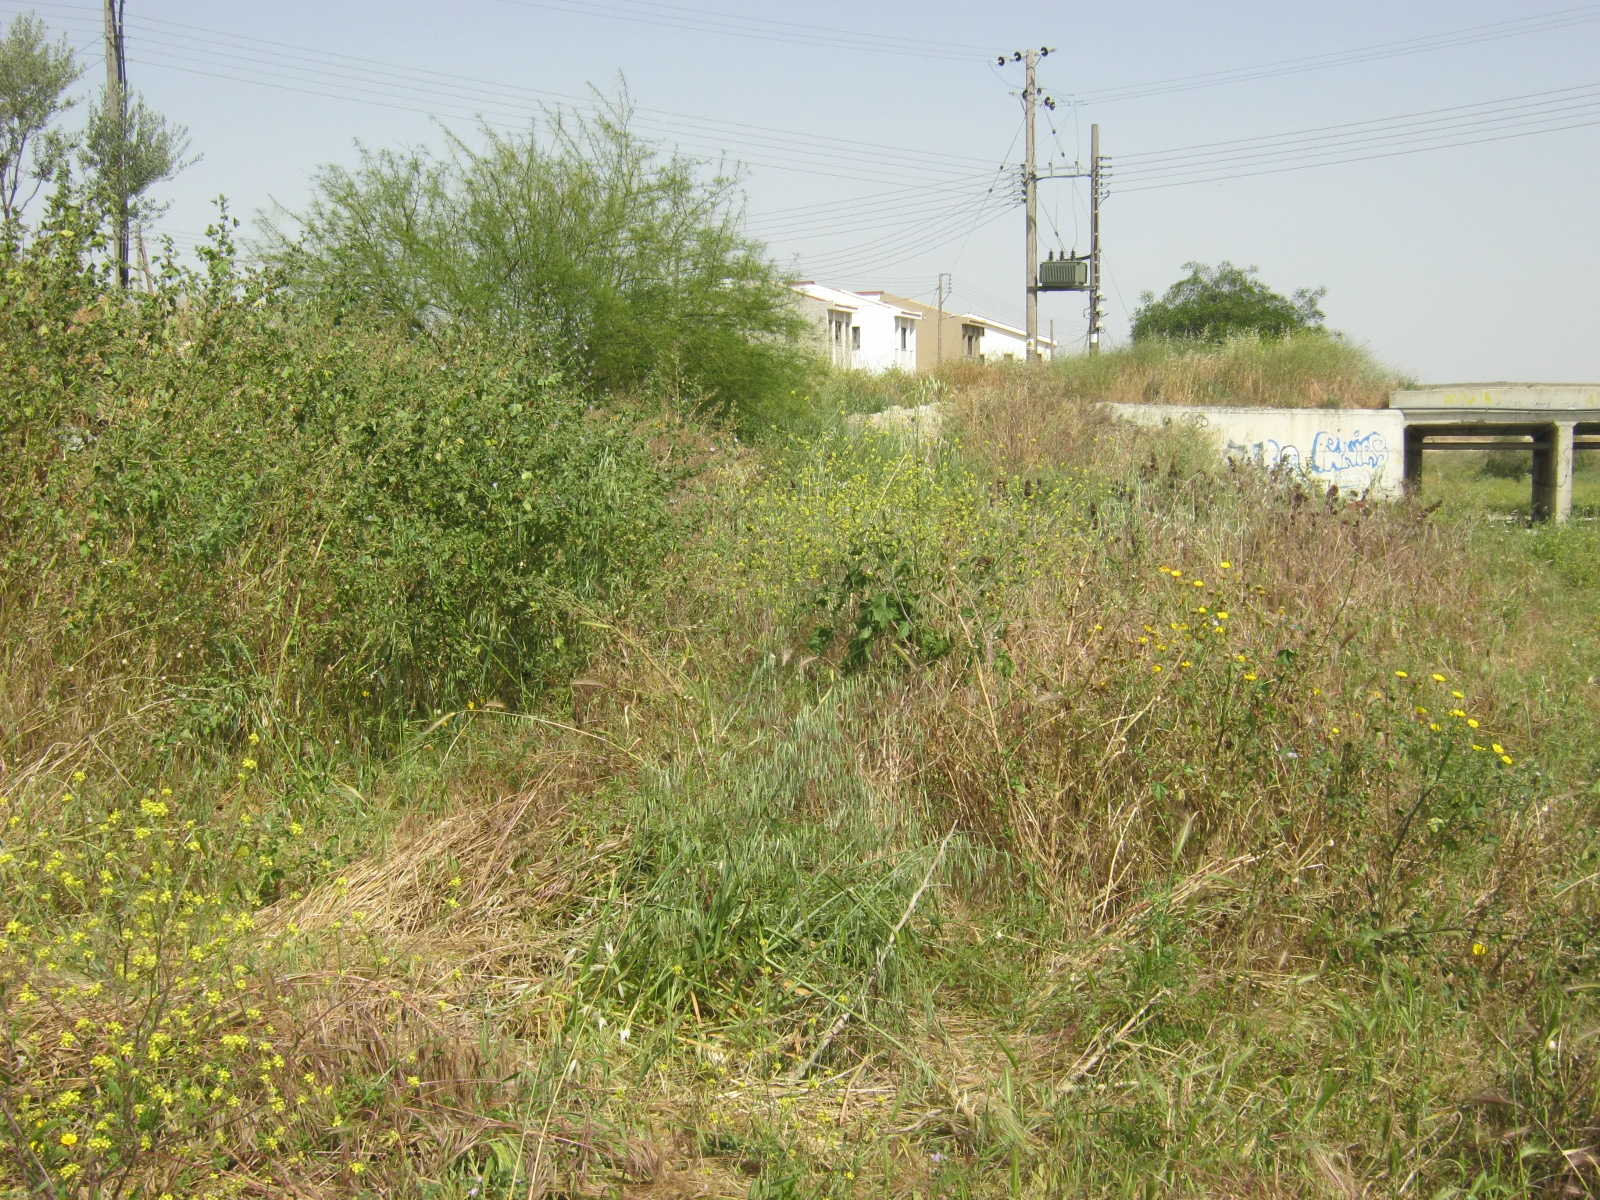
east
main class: Grassland
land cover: Spontaneously vegetated surfaces
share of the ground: > 75 %
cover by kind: herbaceous plants 100 %
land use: Semi-natural and natural areas not in use
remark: Temporary dry
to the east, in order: Spontaneously vegetated surfaces; Grassland with sparse tree/shrub cover; Other bare soil; Artificial constructions in urban areas; Spontaneously vegetated surfaces
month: April
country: CY
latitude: 35.0991
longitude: 33.4174
